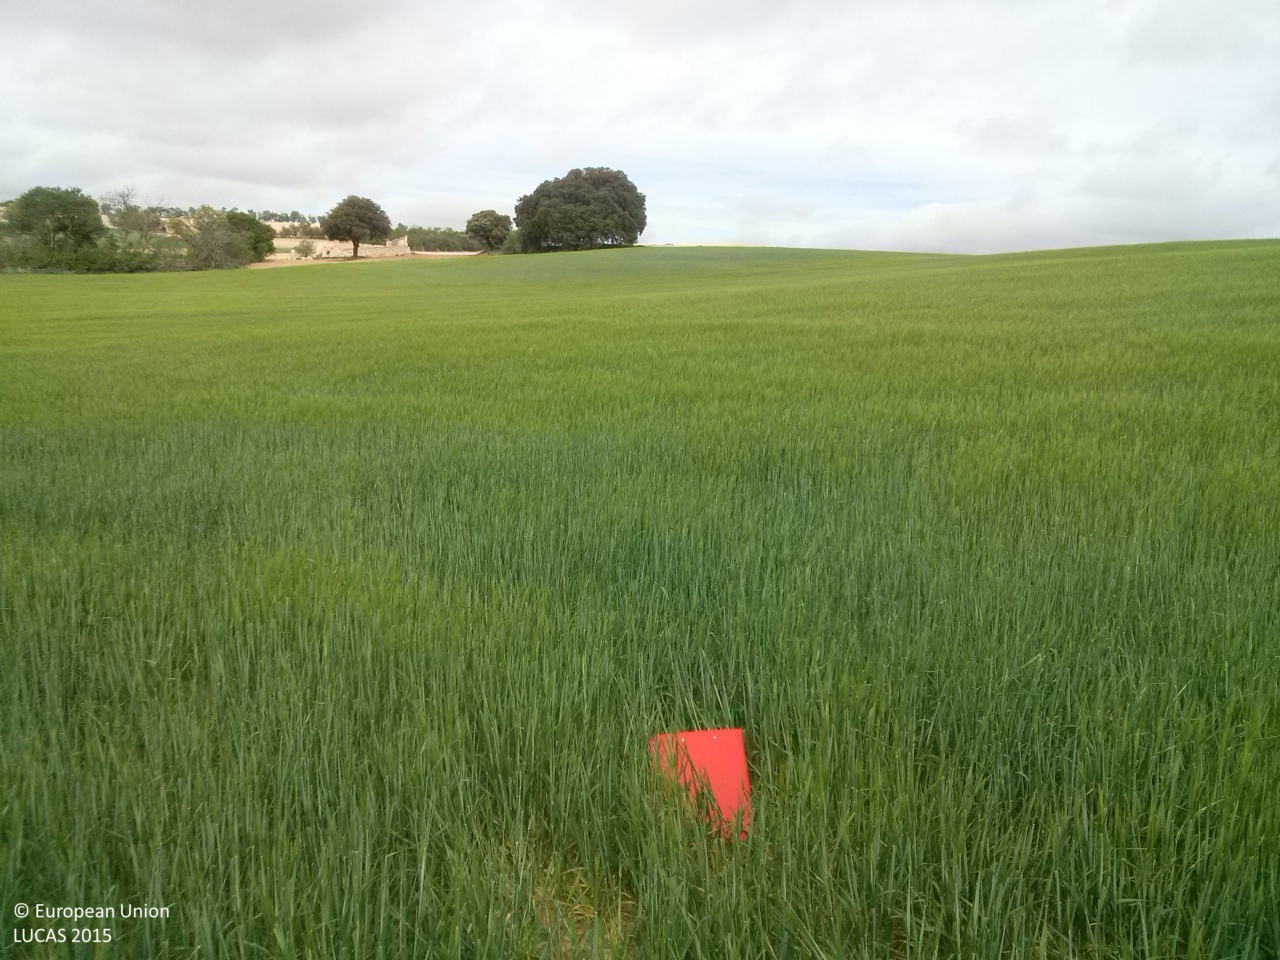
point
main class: Cropland
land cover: Barley
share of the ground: > 75 %
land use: Agriculture (excluding fallow land and kitchen gardens)
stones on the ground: < 10 %
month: May
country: ES
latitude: 39.8555
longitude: -2.8661
